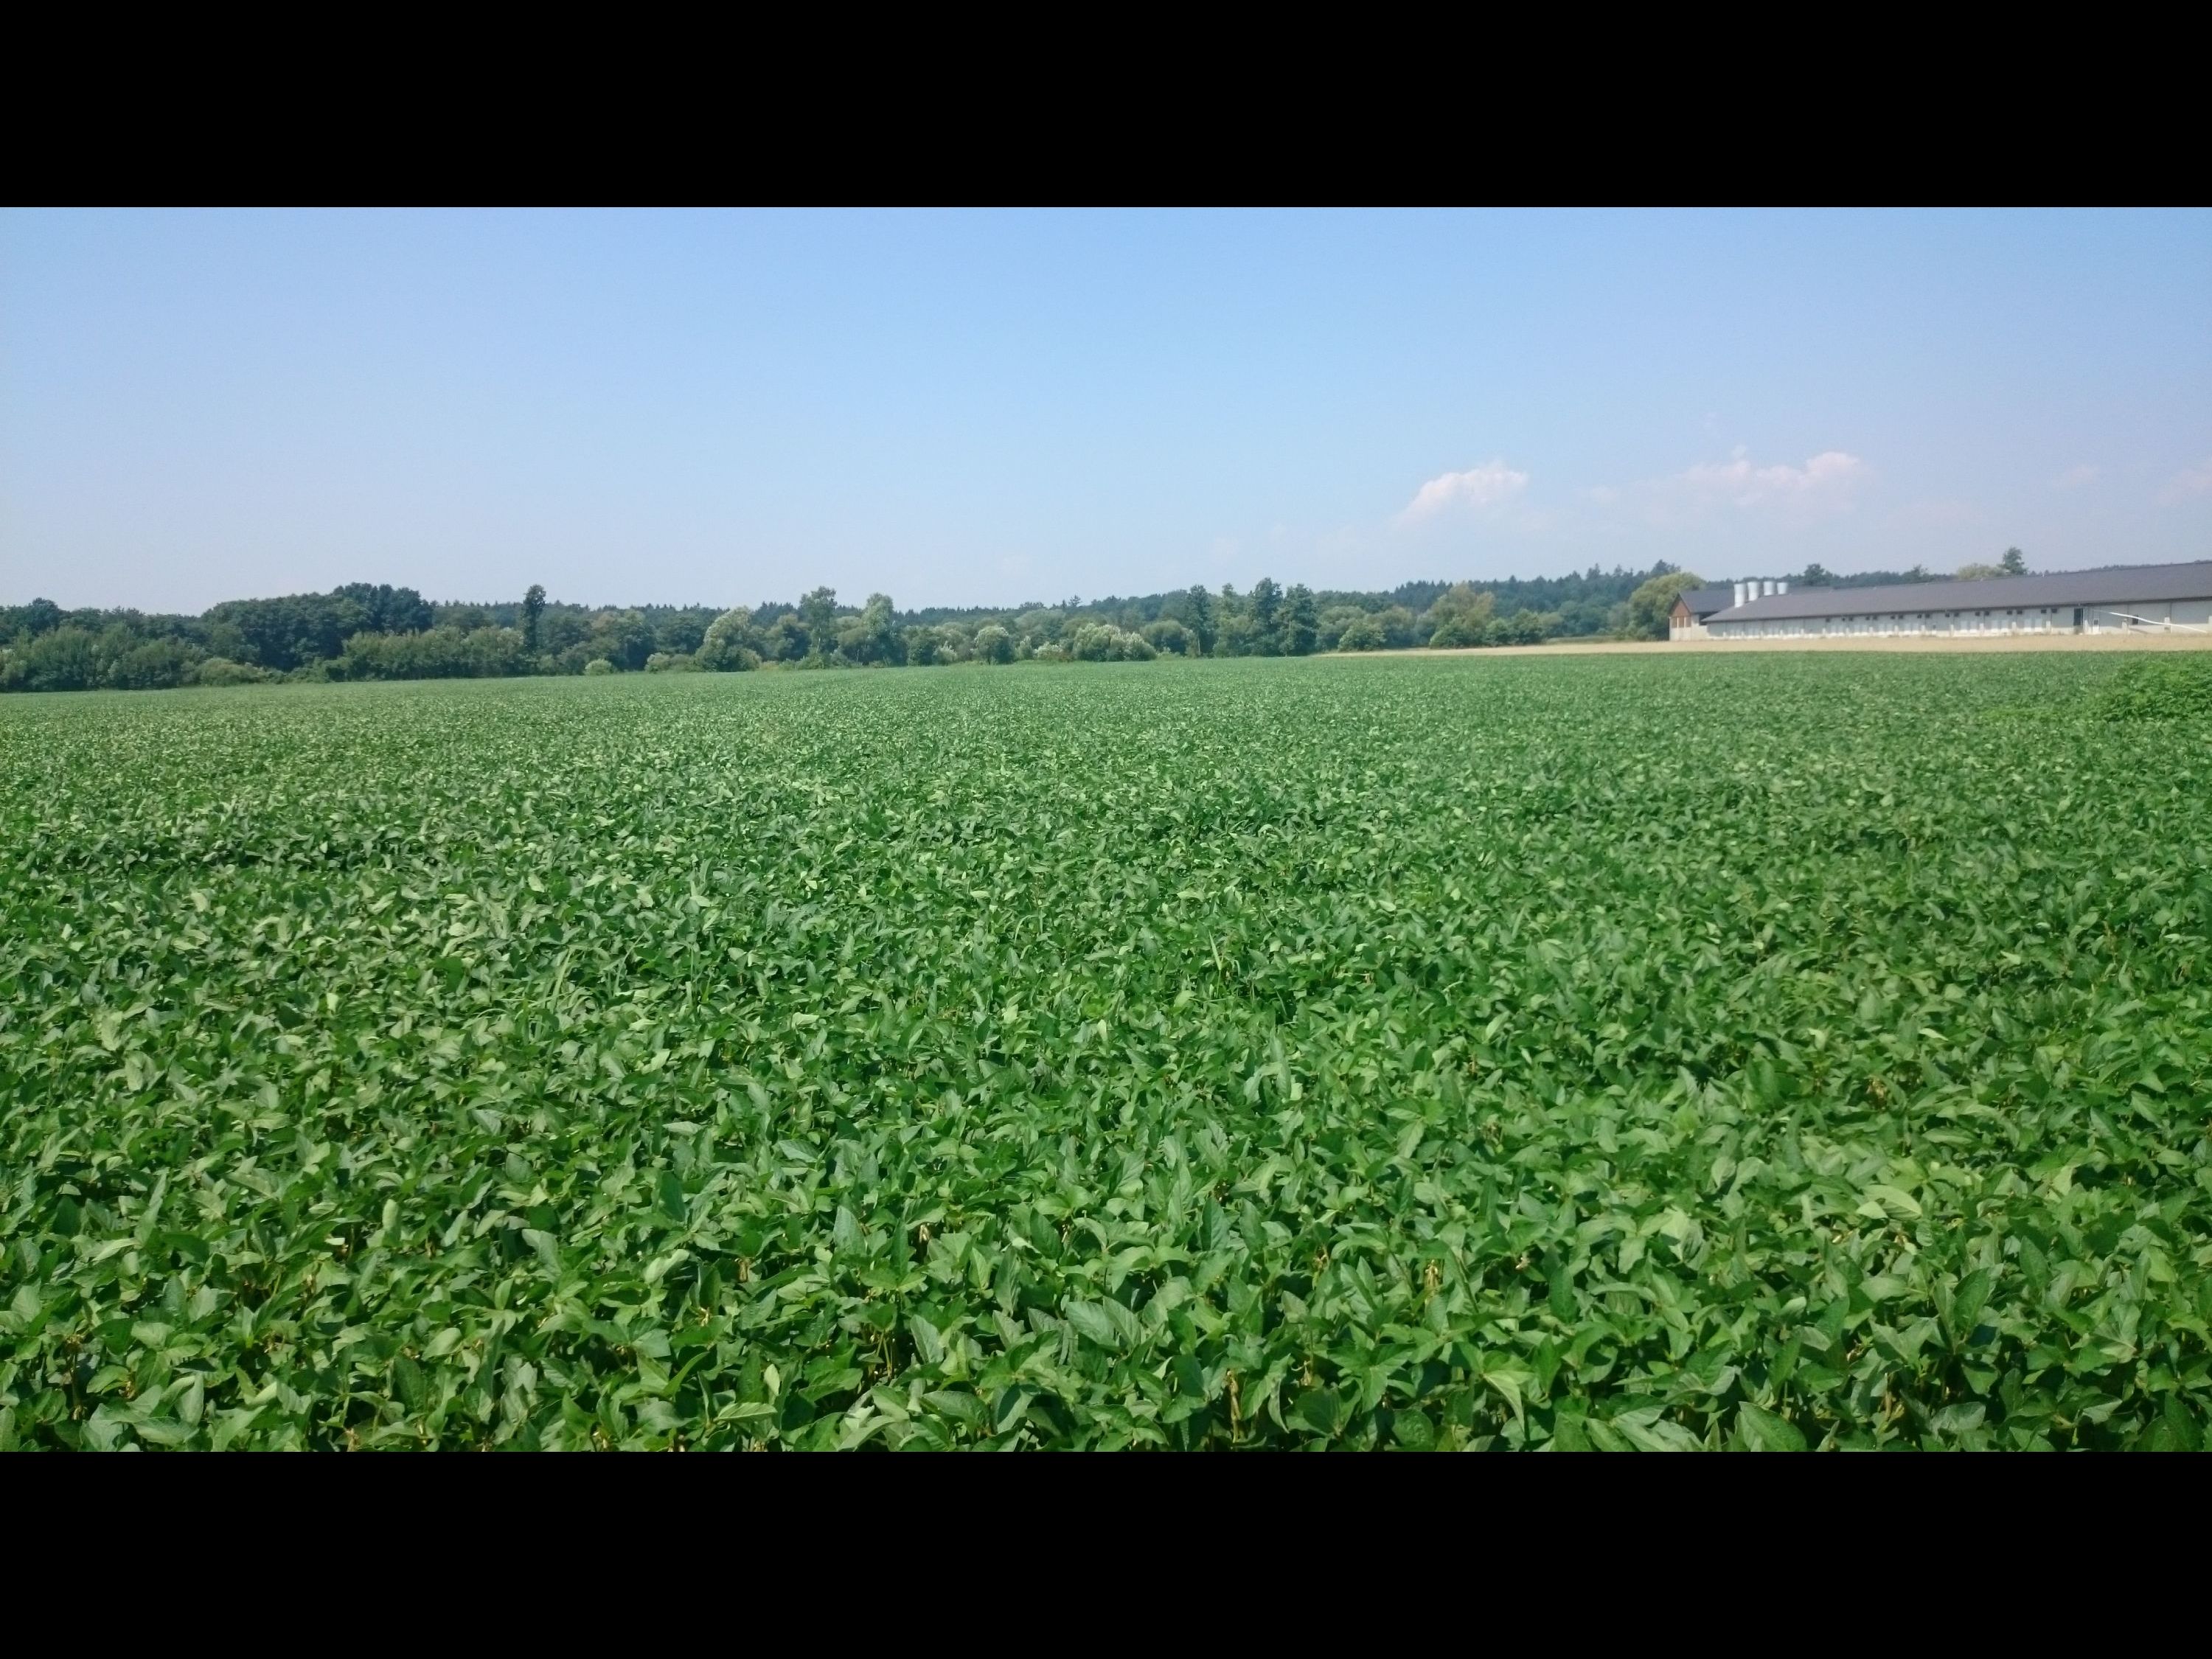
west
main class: Cropland
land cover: Soya
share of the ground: > 75 %
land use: Agriculture (excluding fallow land and kitchen gardens)
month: July
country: AT
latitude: 47.0979
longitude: 16.1016
